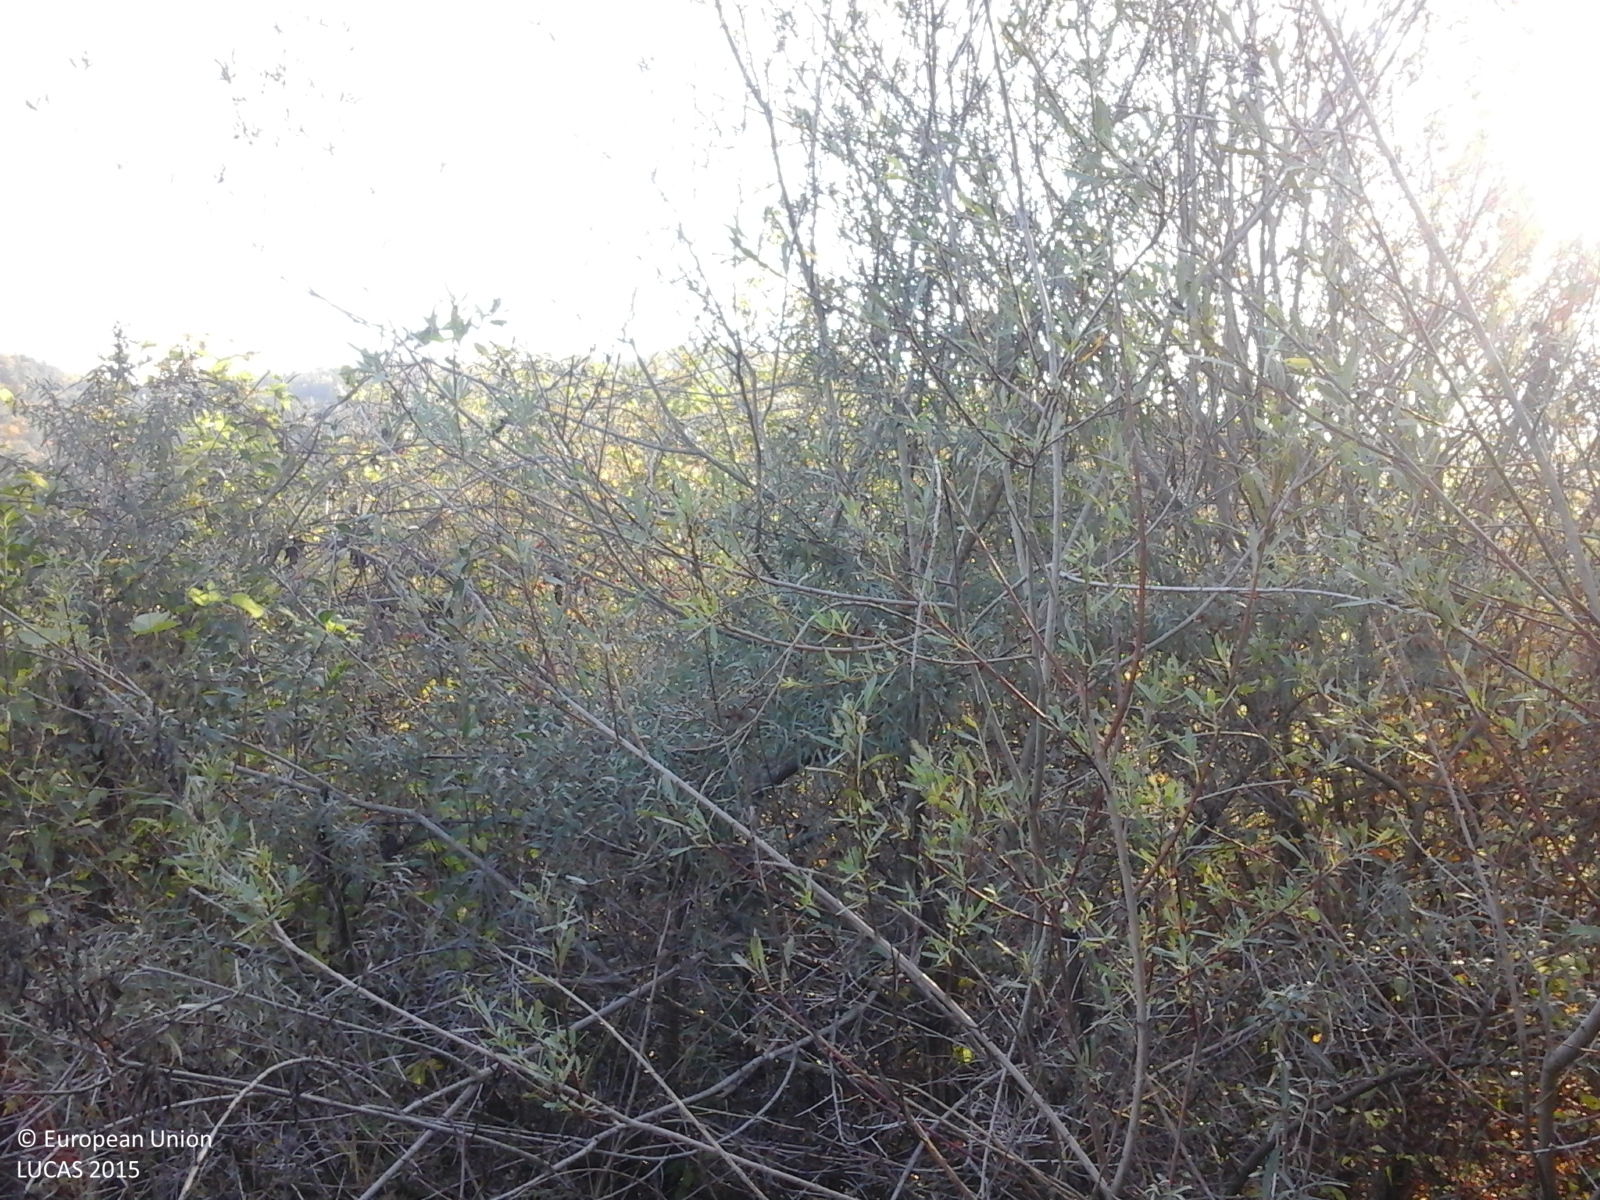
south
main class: Shrubland
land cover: Shrubland without tree cover
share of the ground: > 75 %
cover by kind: shrubs 100 %
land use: Semi-natural and natural areas not in use
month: October
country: RO
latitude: 45.2153
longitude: 26.6683
